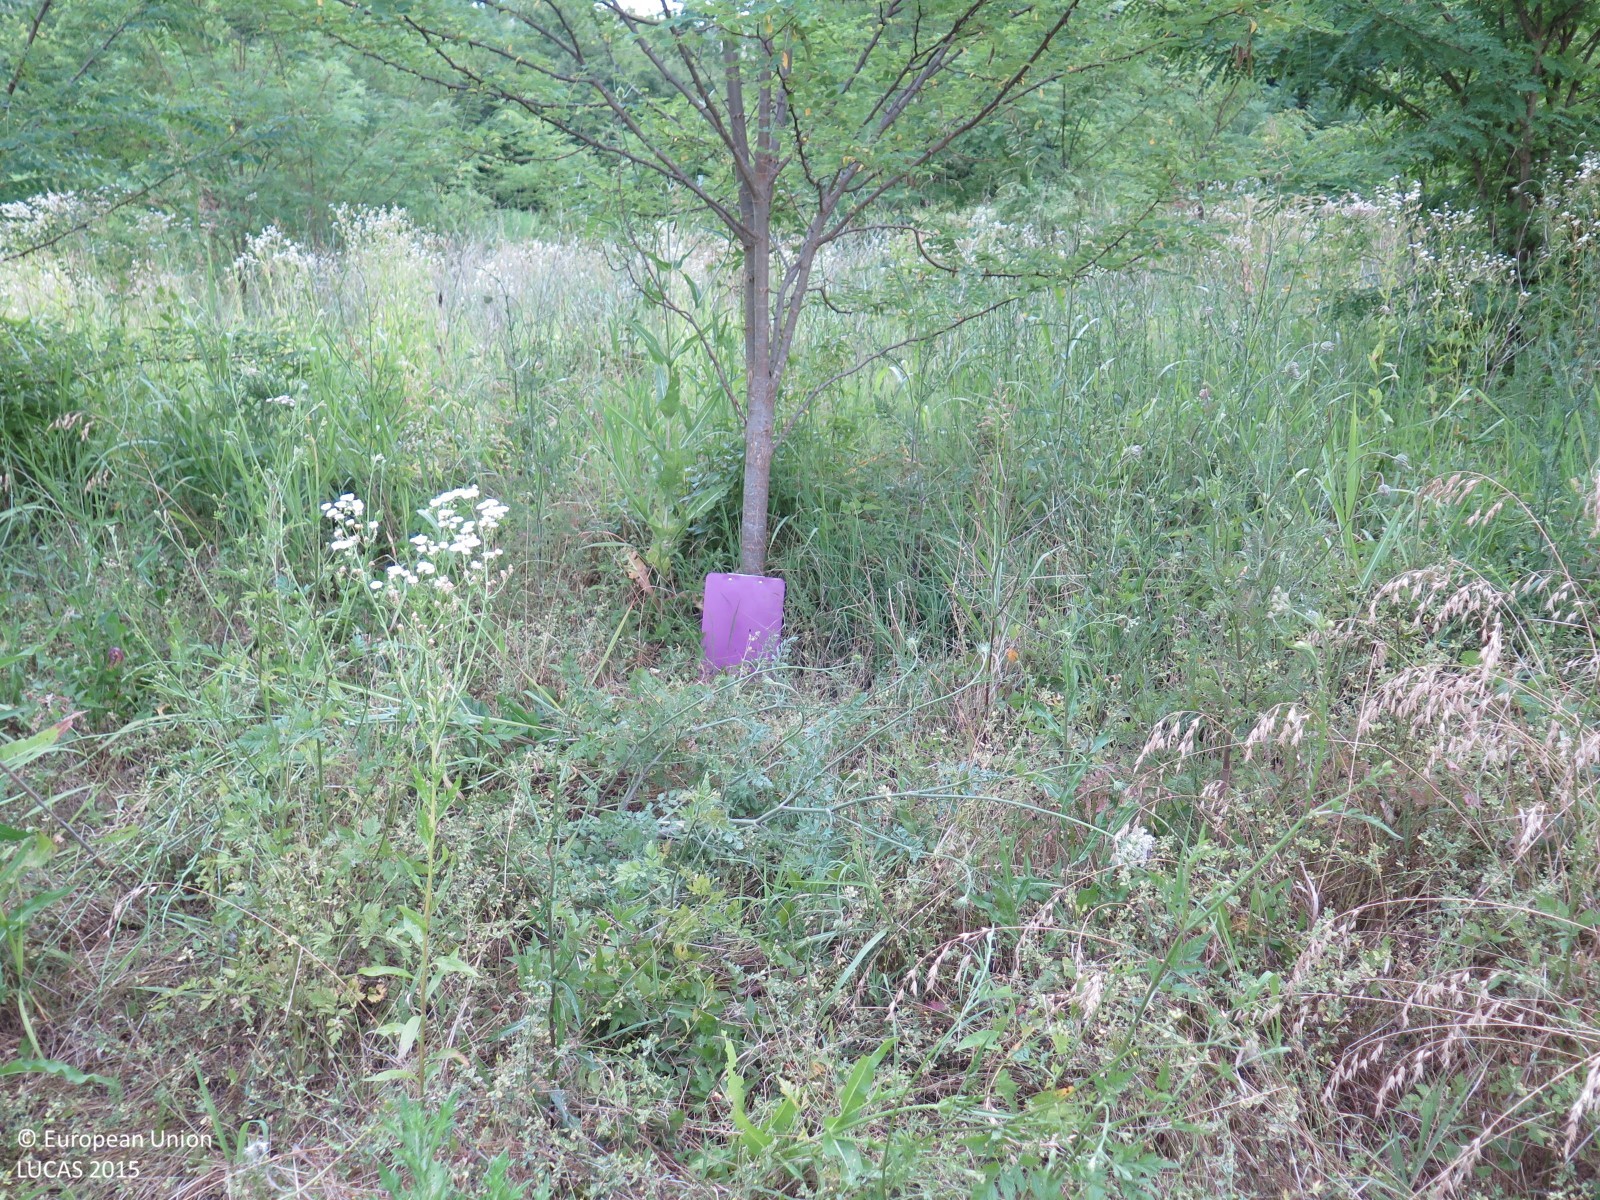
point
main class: Grassland
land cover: Grassland with sparse tree/shrub cover
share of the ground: > 75 %
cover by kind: herbaceous plants 90 %, broadleaved forest trees 5 %, shrubs 5 %
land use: Semi-natural and natural areas not in use
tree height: > 5 m
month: July
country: HR
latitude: 45.3274
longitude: 13.8099
